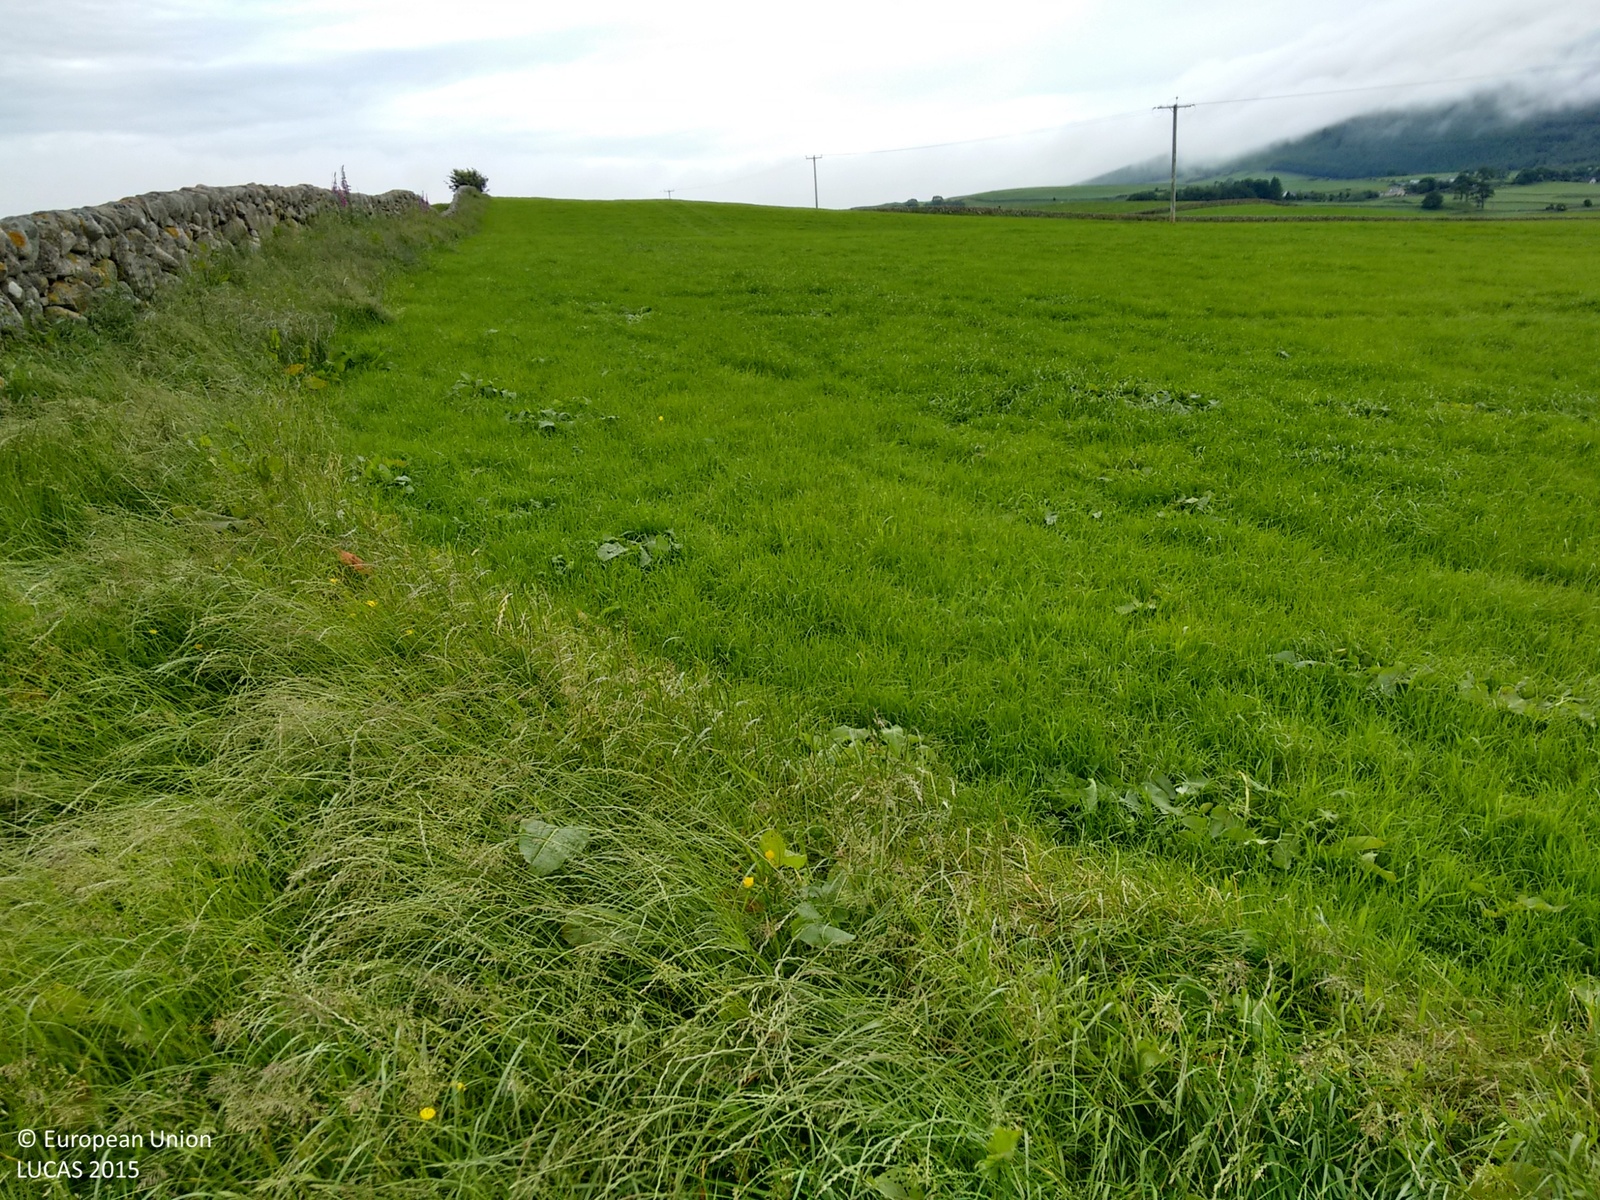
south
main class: Grassland
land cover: Grassland without tree/shrub cover
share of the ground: > 75 %
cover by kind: herbaceous plants 100 %
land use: Agriculture (excluding fallow land and kitchen gardens)
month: July
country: GB
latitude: 54.9667
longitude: -3.5939
